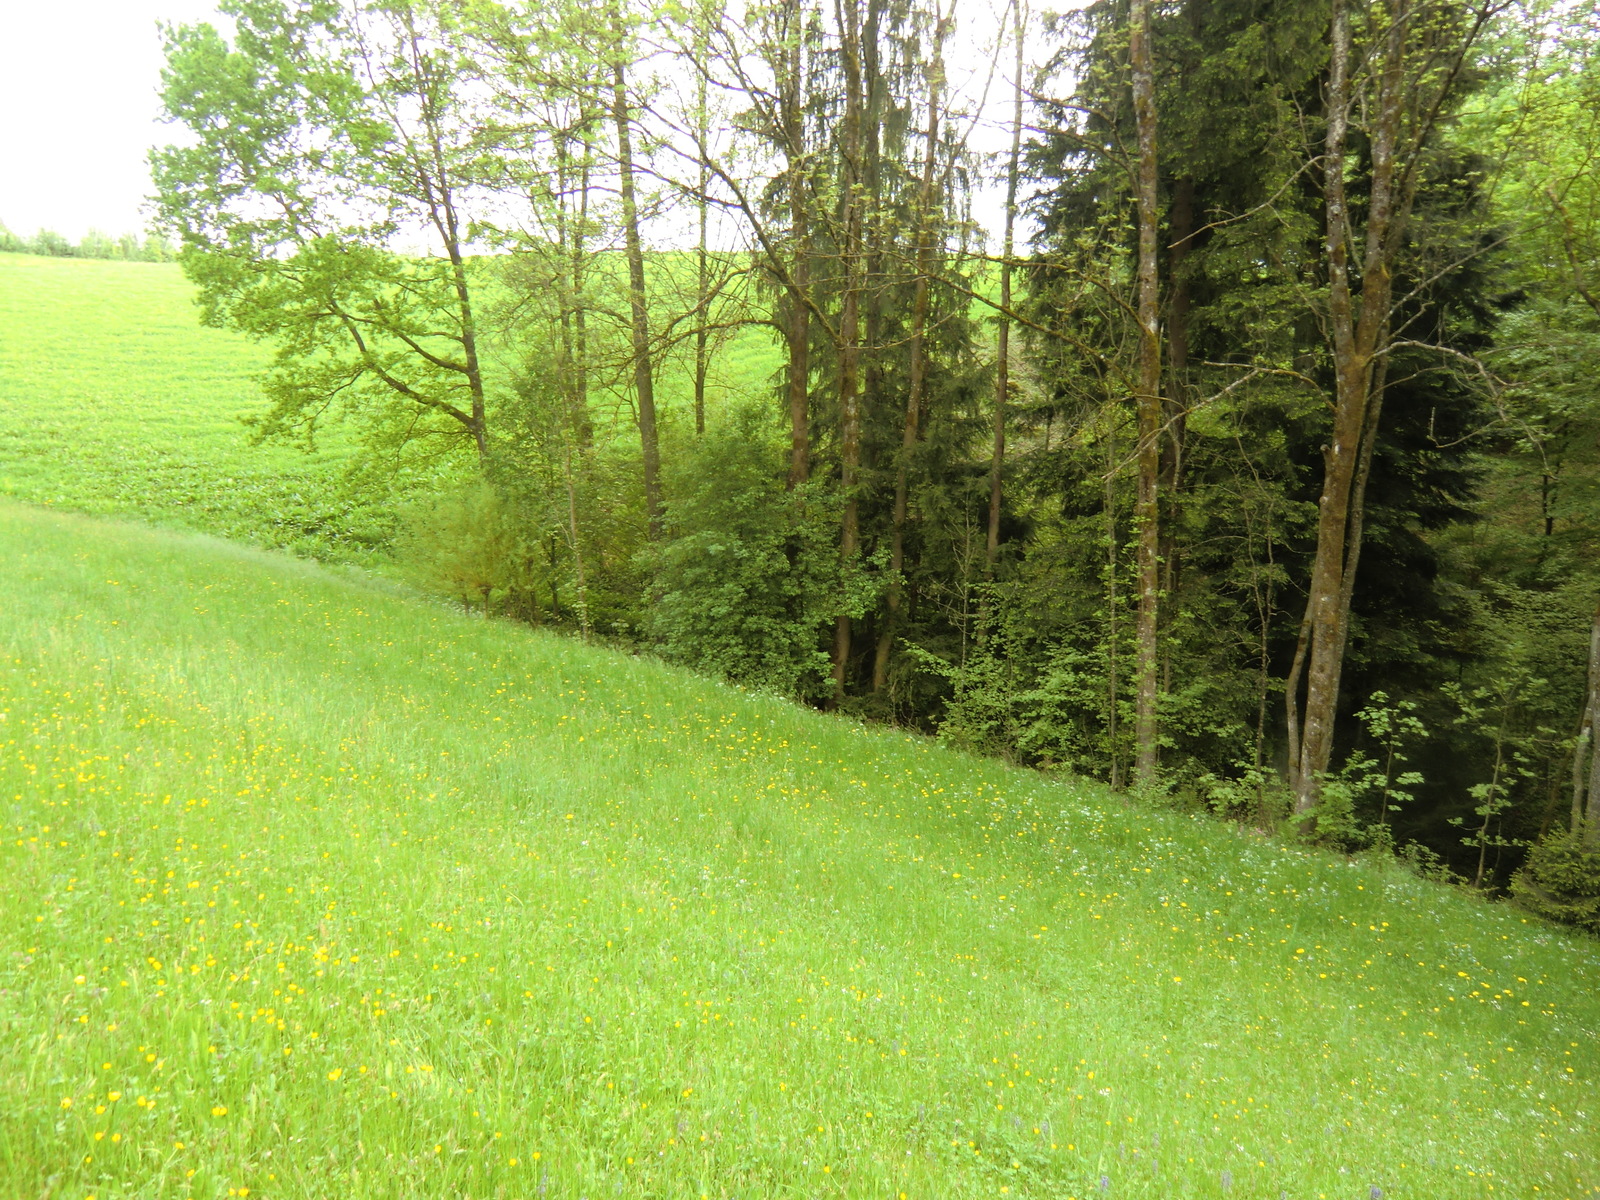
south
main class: Grassland
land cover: Grassland without tree/shrub cover
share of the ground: > 75 %
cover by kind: herbaceous plants 100 %
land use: Agriculture (excluding fallow land and kitchen gardens)
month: May
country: AT
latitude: 48.2808
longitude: 14.8118
